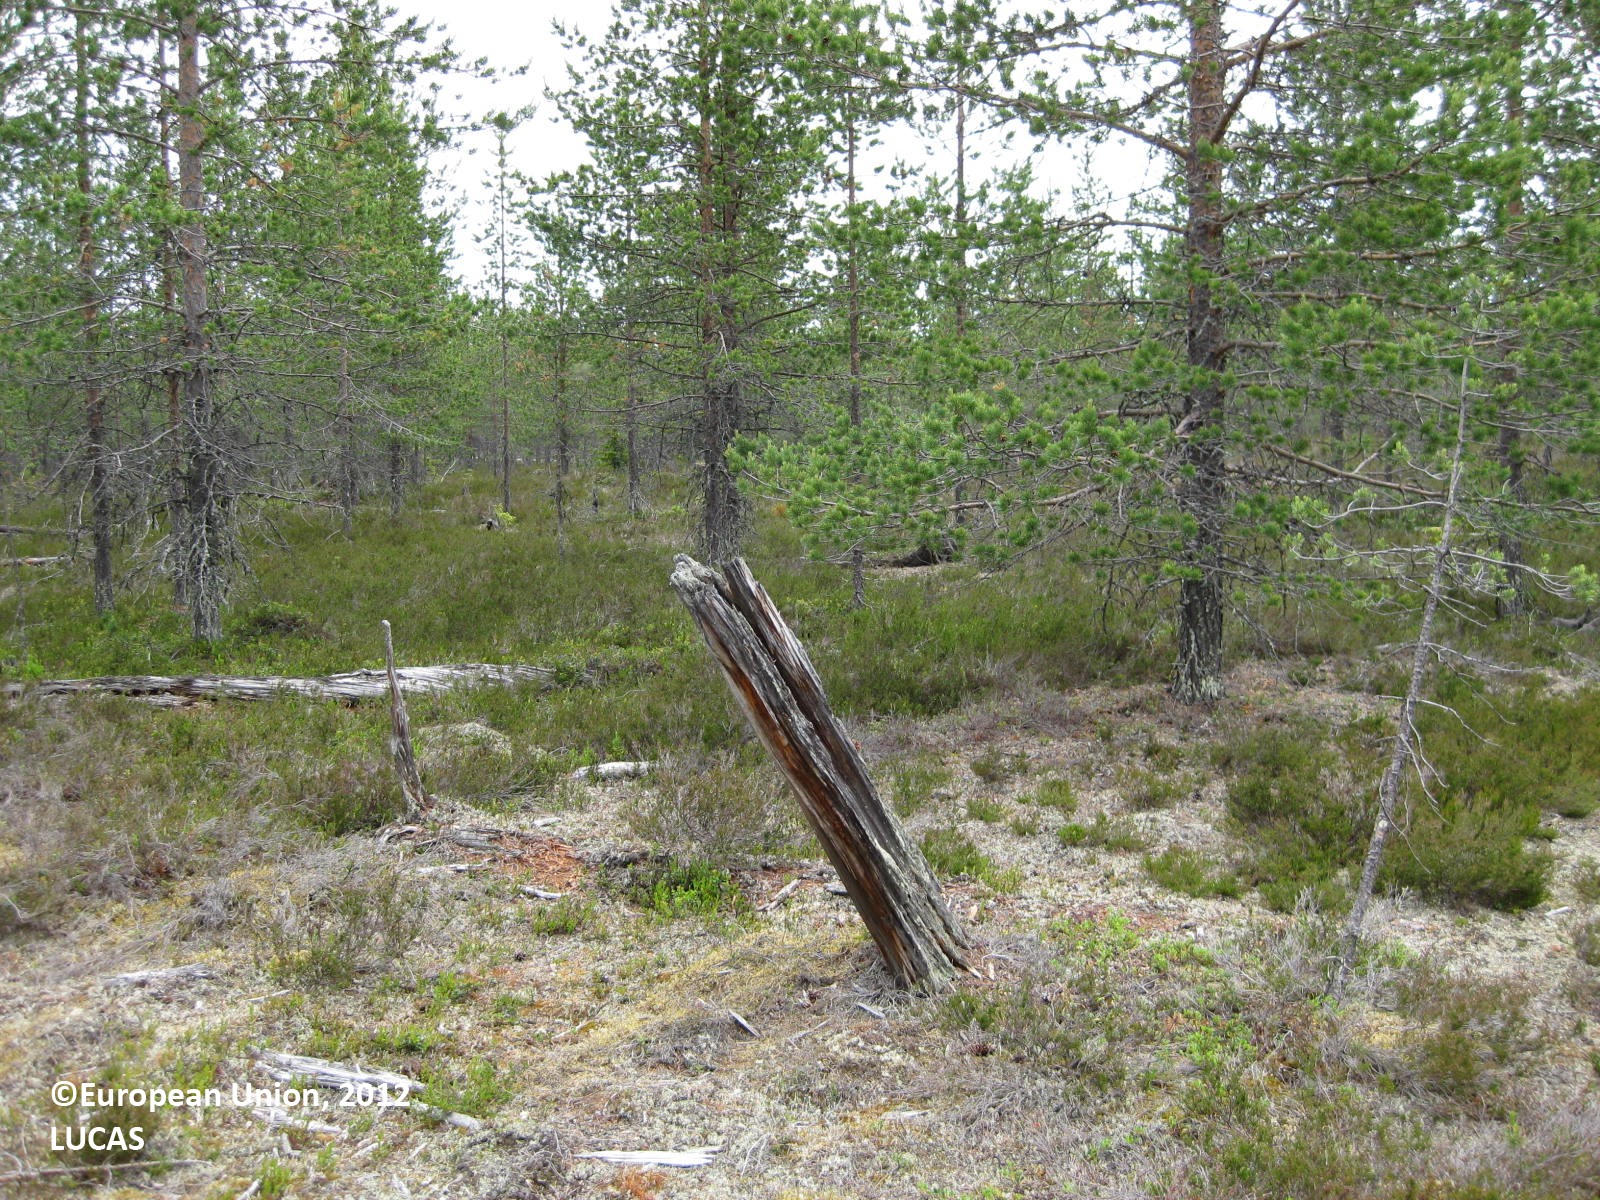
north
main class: Woodland
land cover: Pine dominated coniferous woodland
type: boreal forest
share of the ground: 25 - 50 %
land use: Forestry
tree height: > 5 m
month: July
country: FI
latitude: 65.5988
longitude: 29.2558
